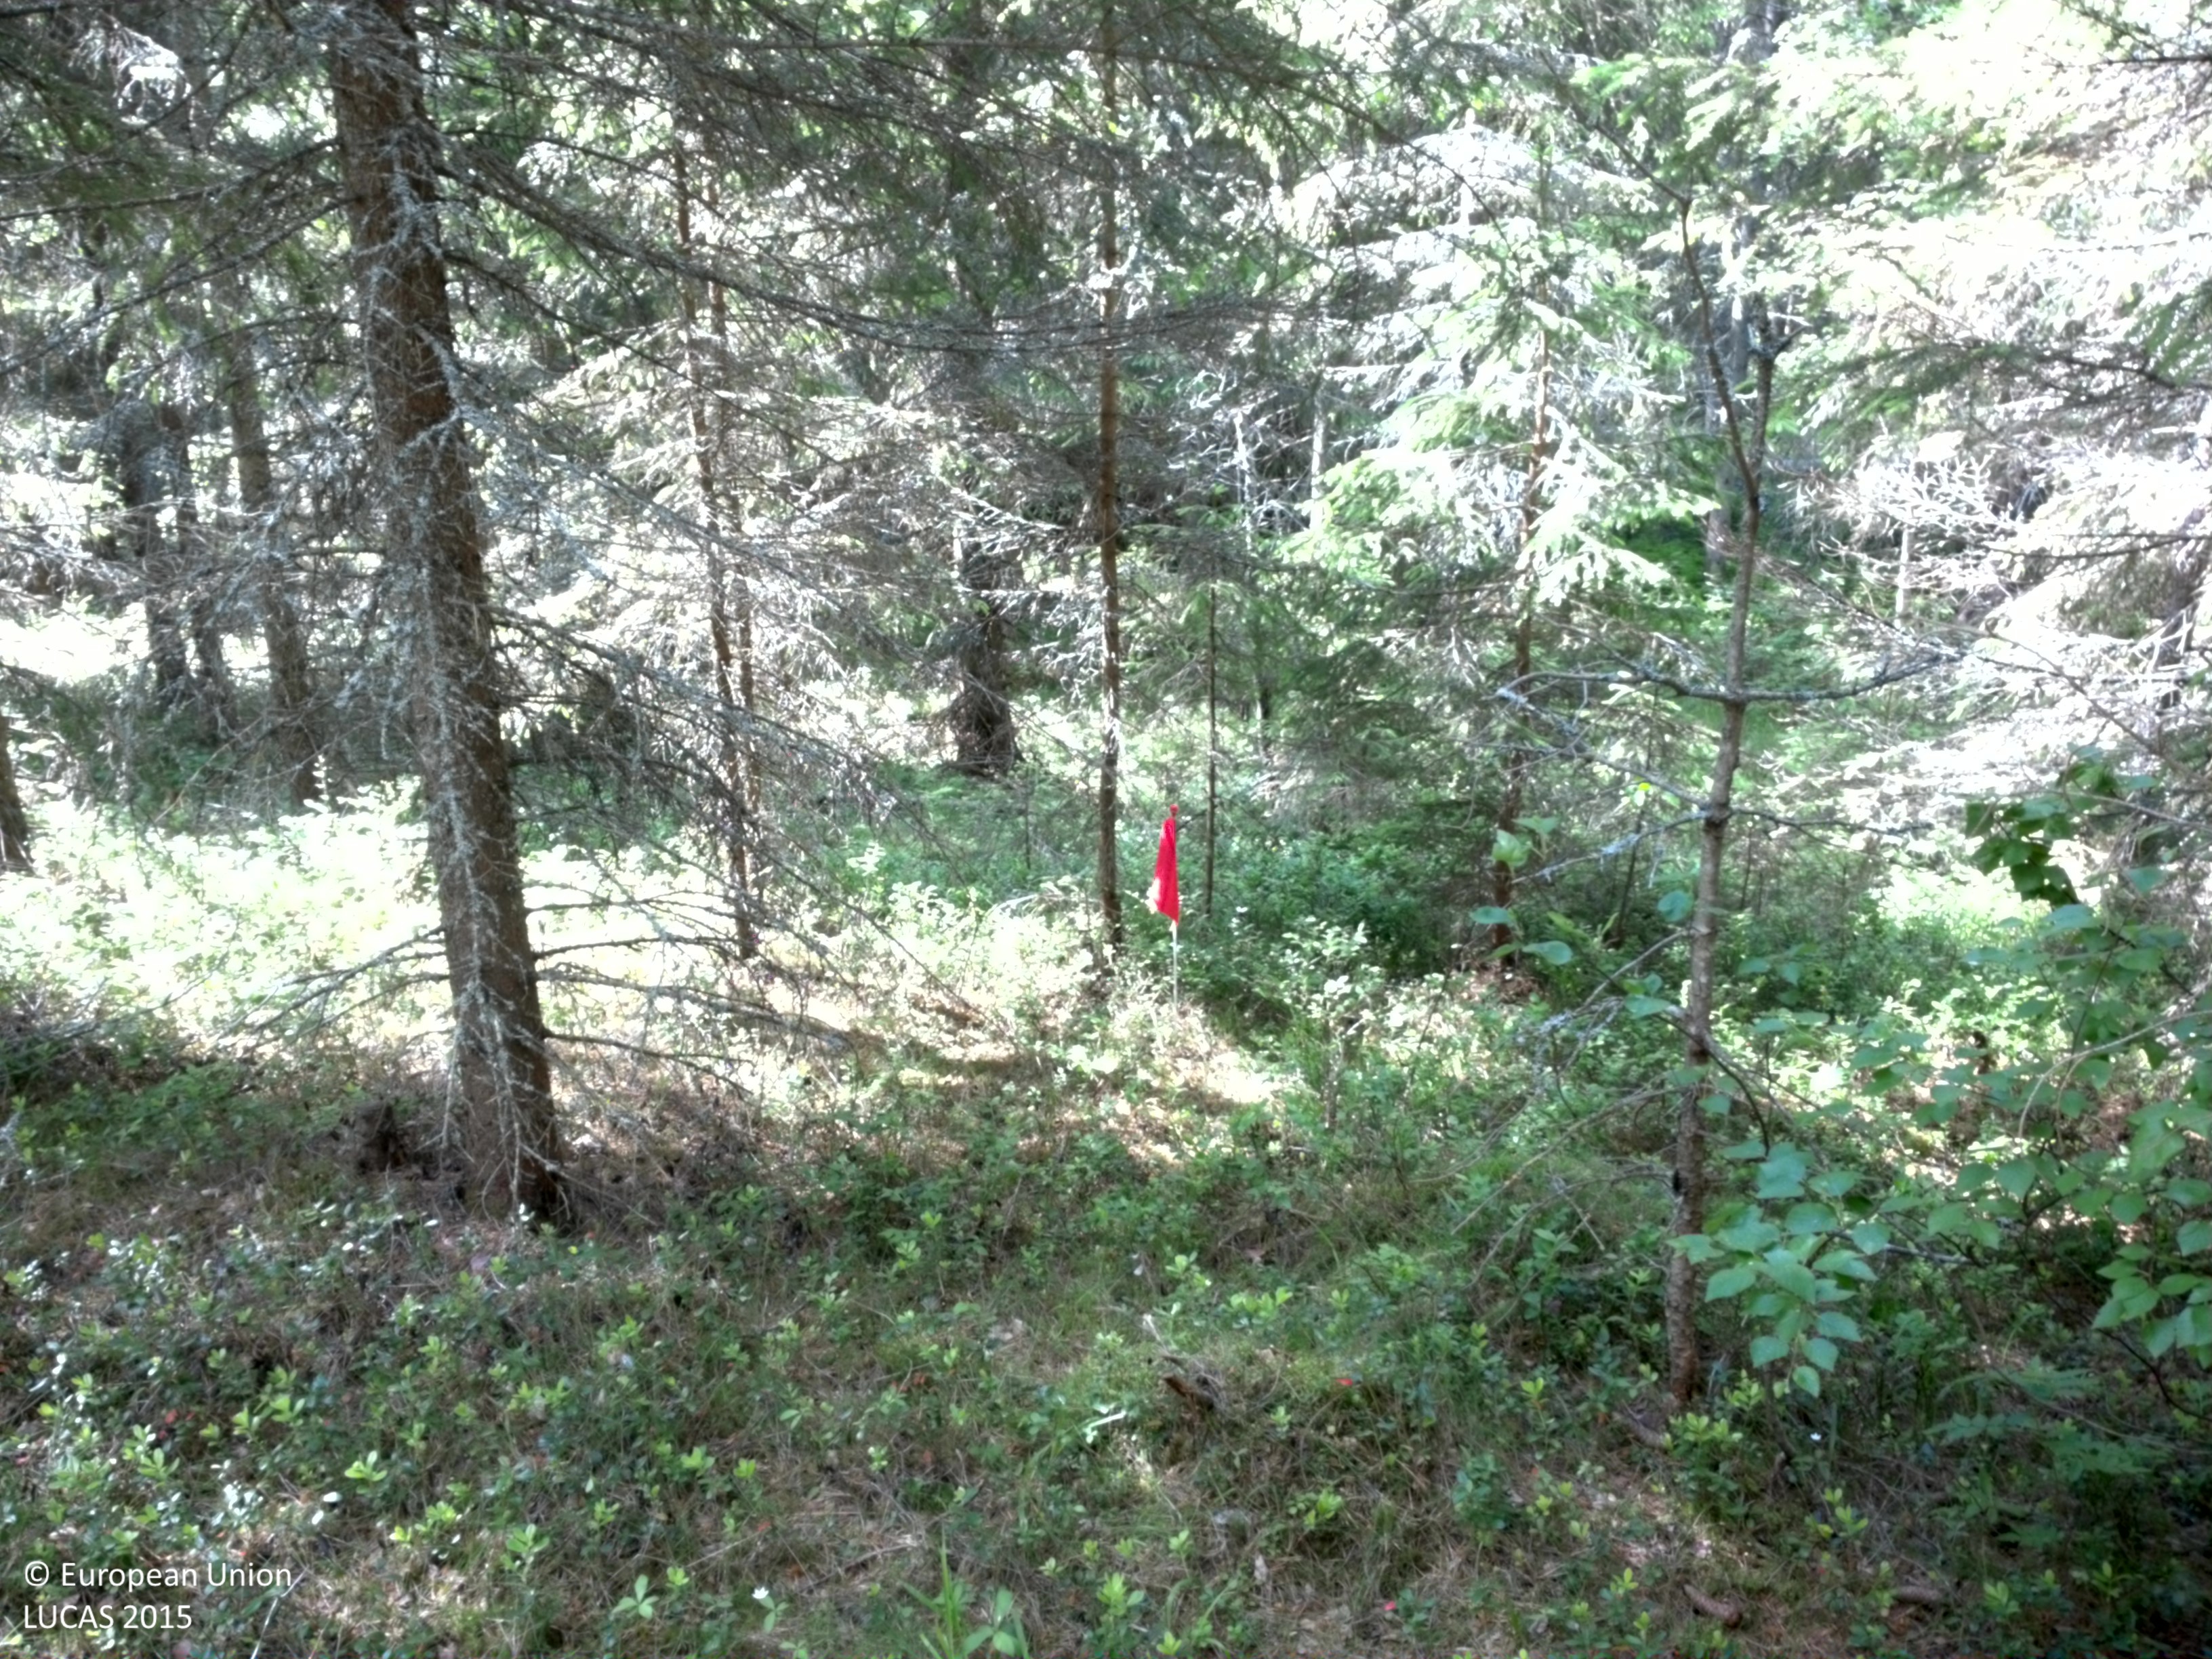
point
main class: Woodland
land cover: Spruce dominated coniferous woodland
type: boreal forest
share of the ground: 50 - 75 %
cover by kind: coniferous forest trees 75 %, shrubs 20 %, herbaceous plants 5 %
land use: Forestry
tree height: > 5 m
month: July
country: SE
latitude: 64.3005
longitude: 20.8322
